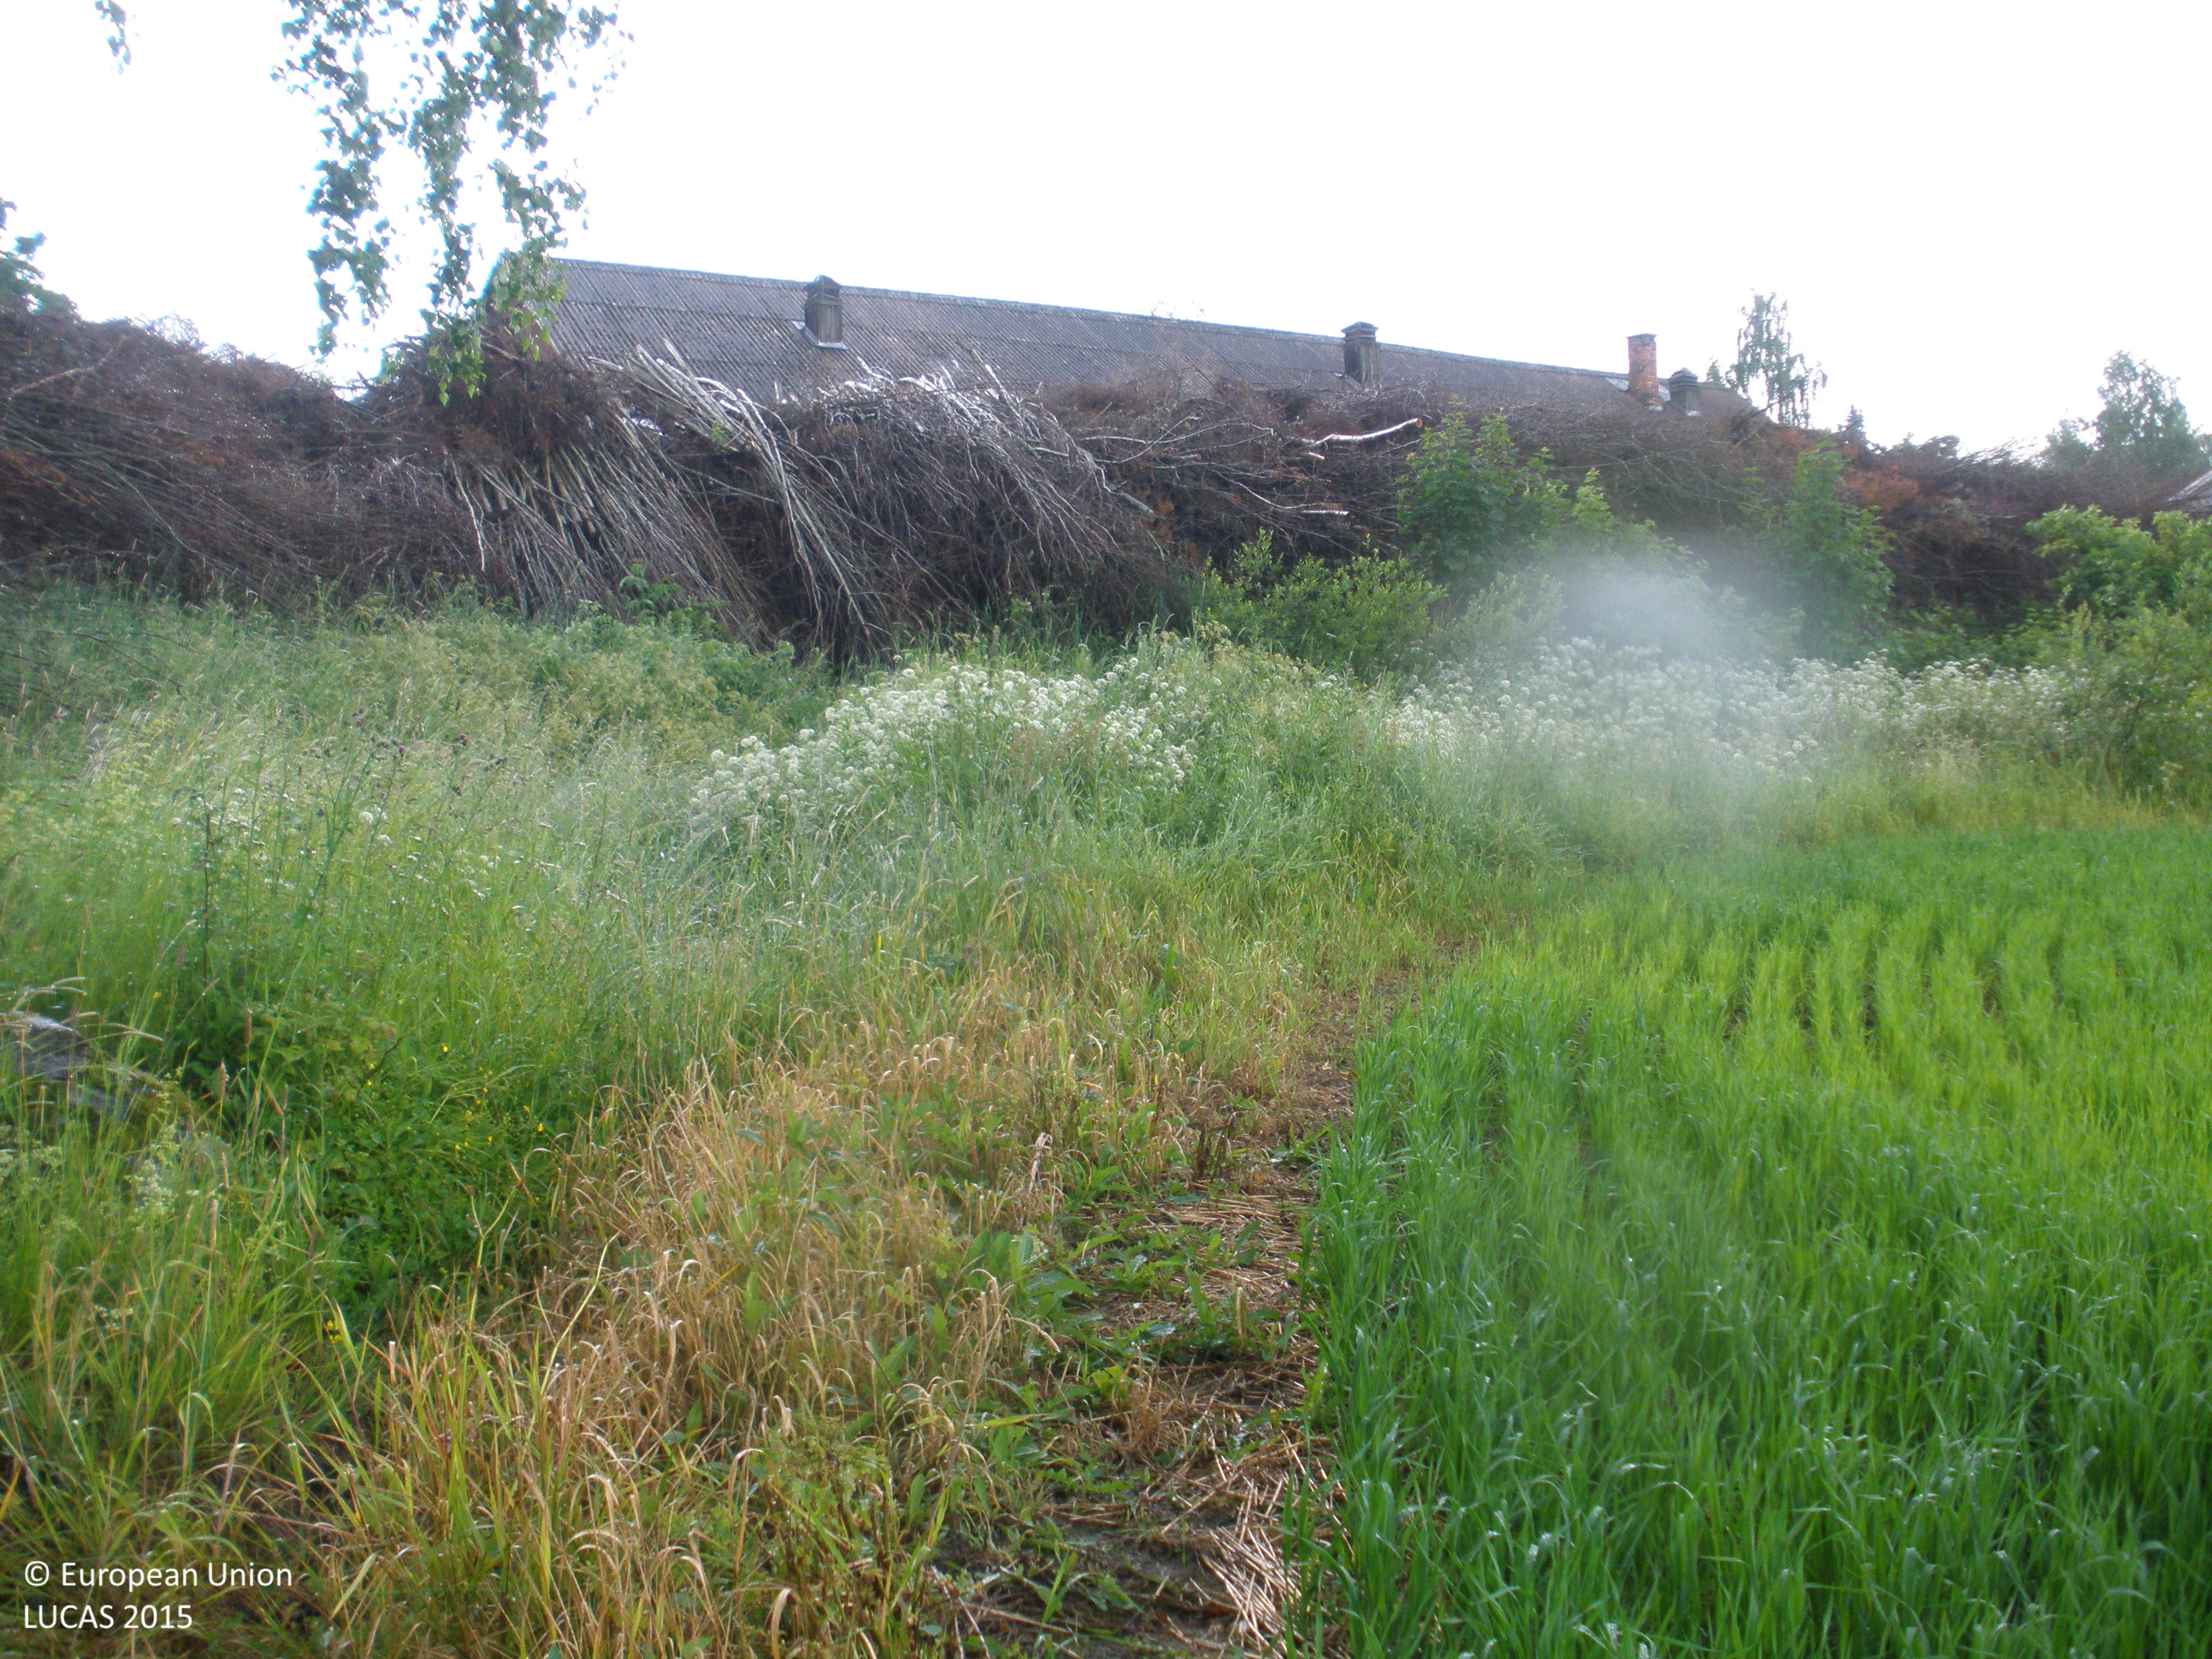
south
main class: Cropland
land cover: Oats
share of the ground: > 75 %
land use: Agriculture (excluding fallow land and kitchen gardens)
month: July
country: FI
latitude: 61.3182
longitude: 23.7386
